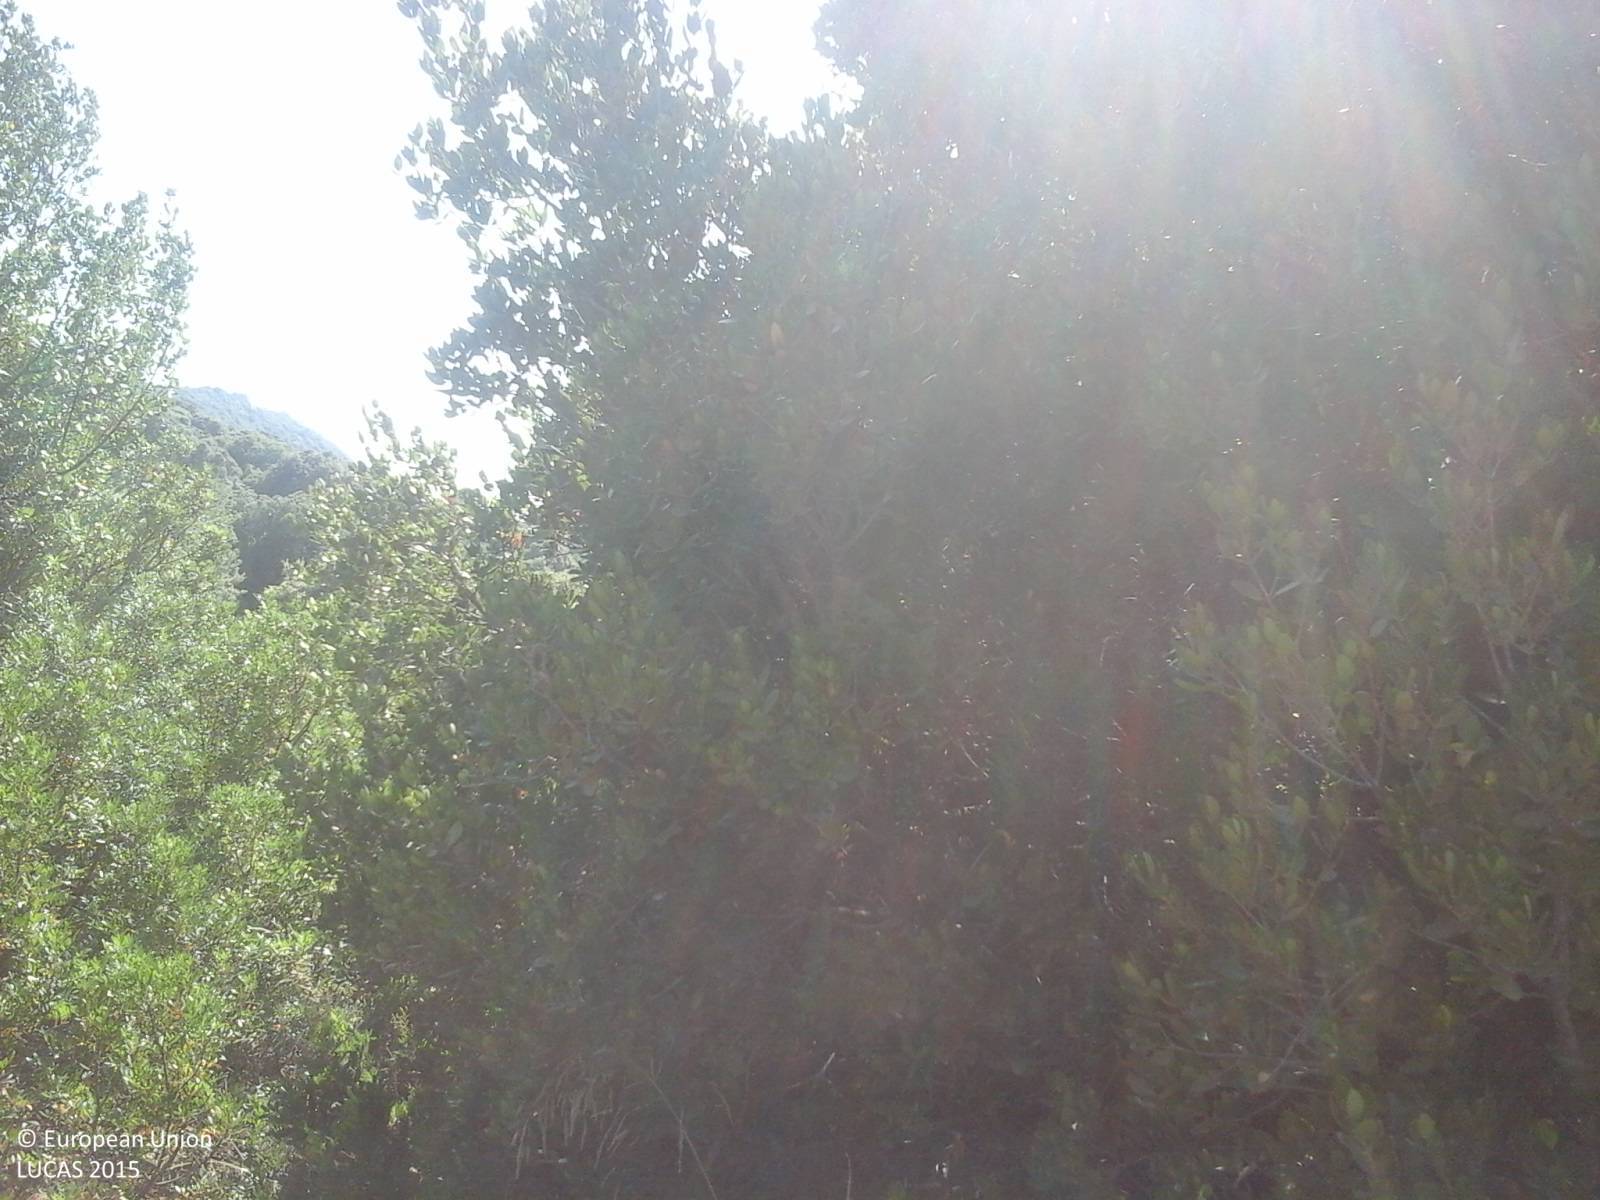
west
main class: Shrubland
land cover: Shrubland with sparse tree cover
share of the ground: > 75 %
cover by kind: shrubs 95 %, broadleaved forest trees 5 %
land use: Semi-natural and natural areas not in use
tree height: > 5 m
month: July
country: IT
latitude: 40.7903
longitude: 9.3985
